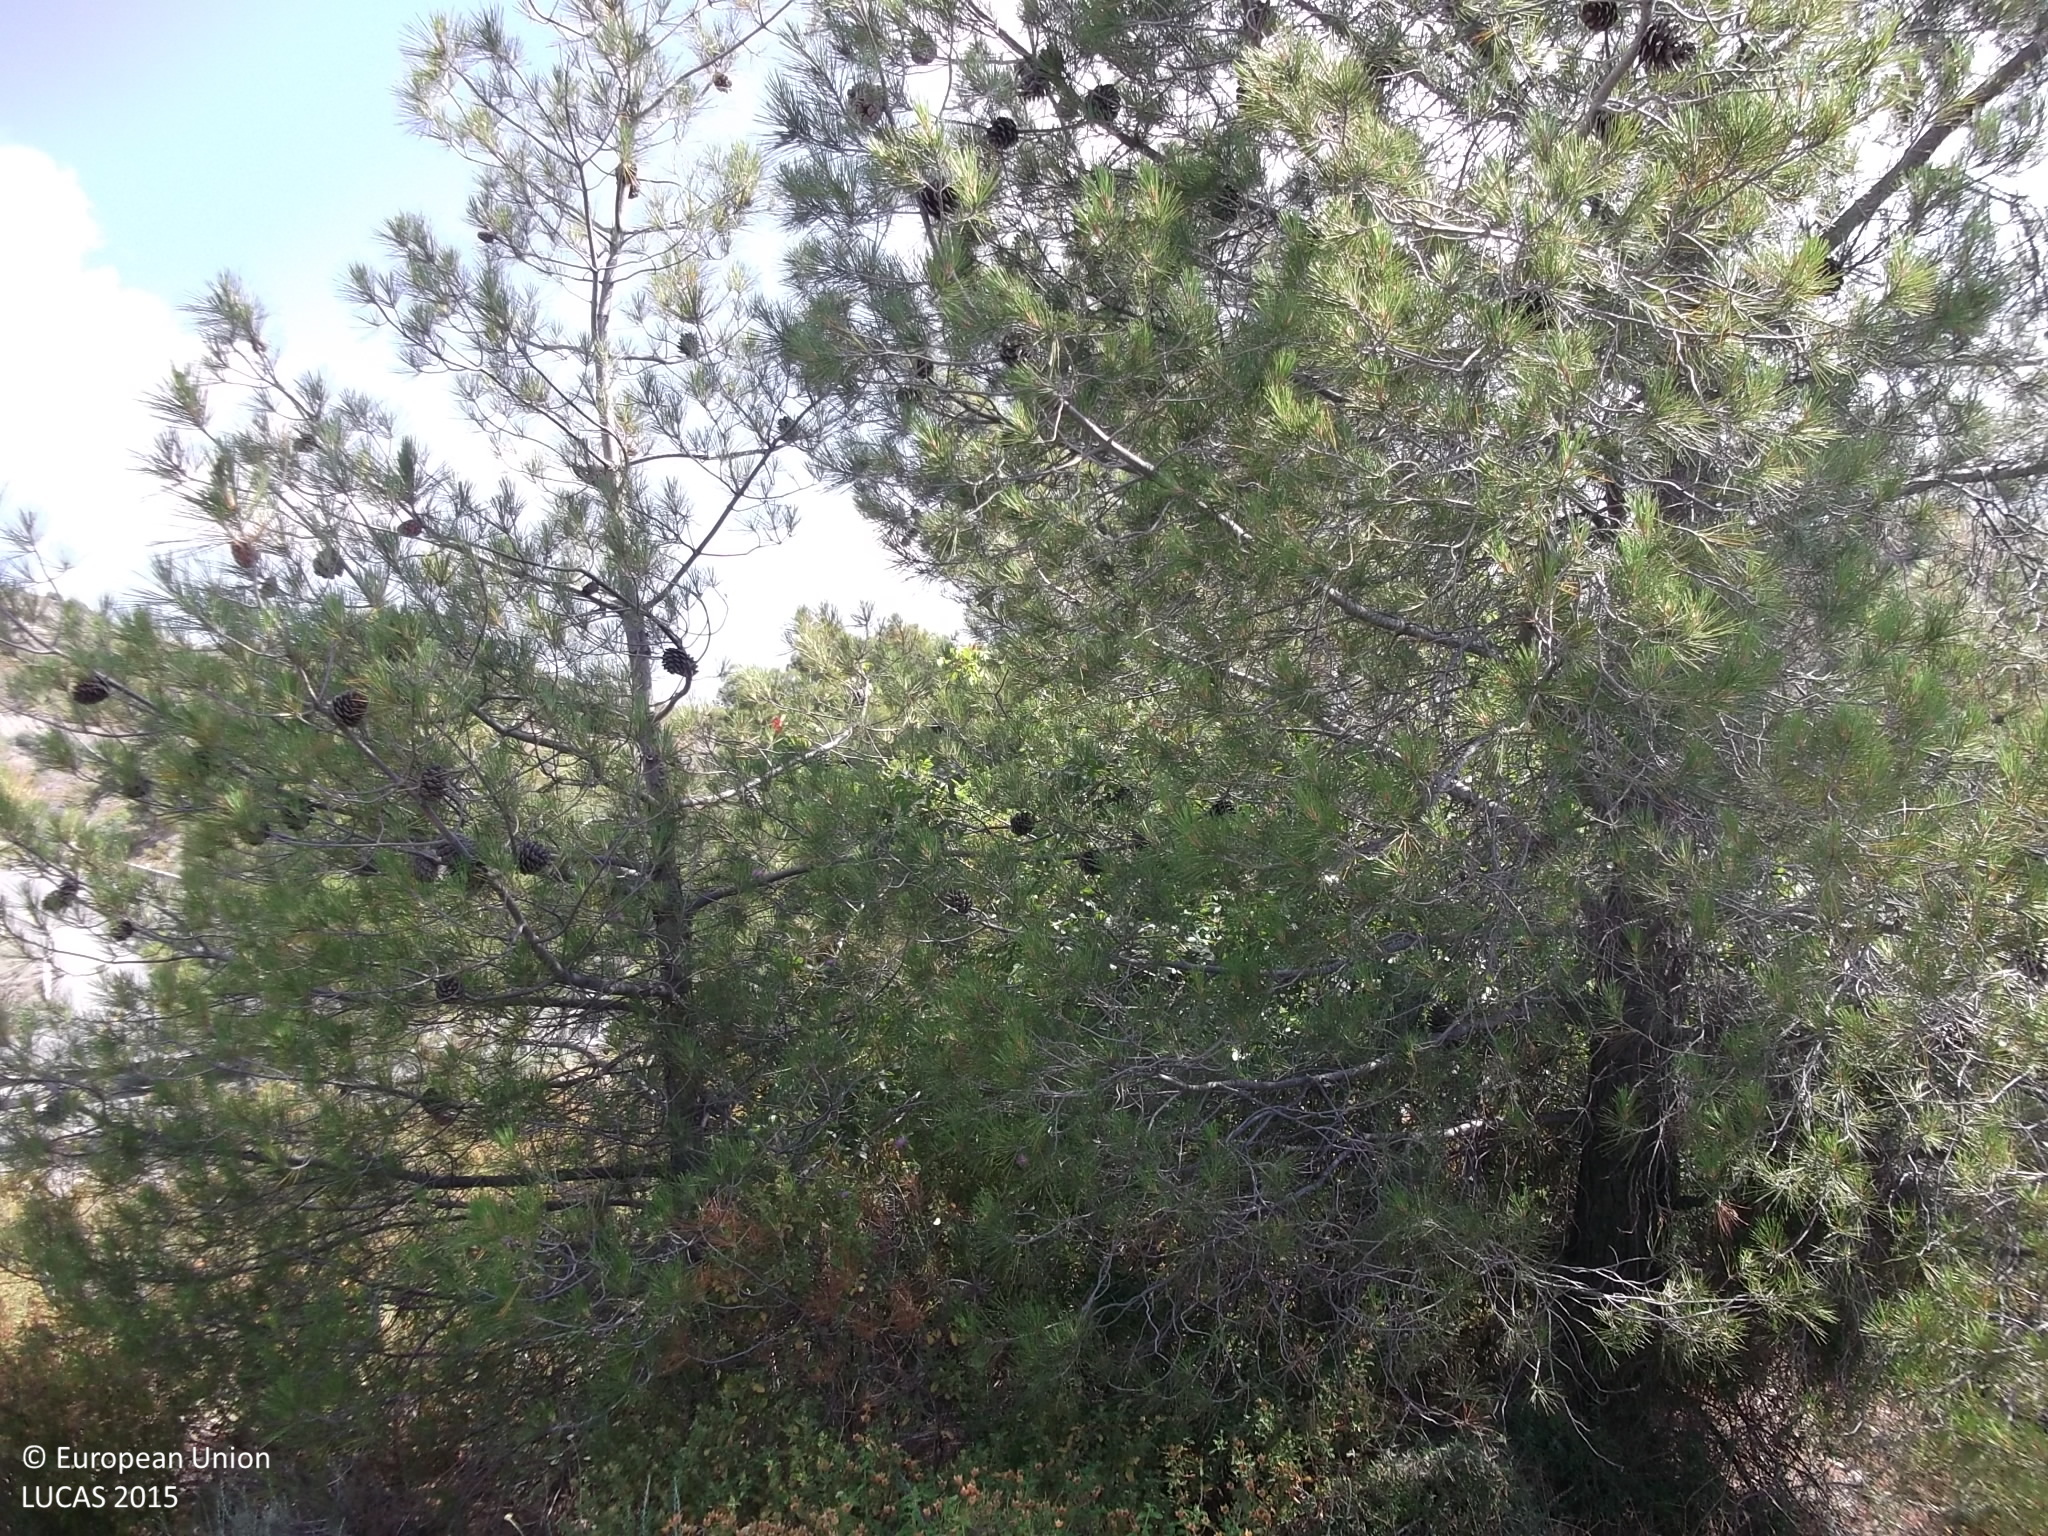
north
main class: Shrubland
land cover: Shrubland with sparse tree cover
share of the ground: > 75 %
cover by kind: shrubs 95 %, broadleaved forest trees 5 %
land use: Semi-natural and natural areas not in use
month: June
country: CY
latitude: 34.8678
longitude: 32.9312
